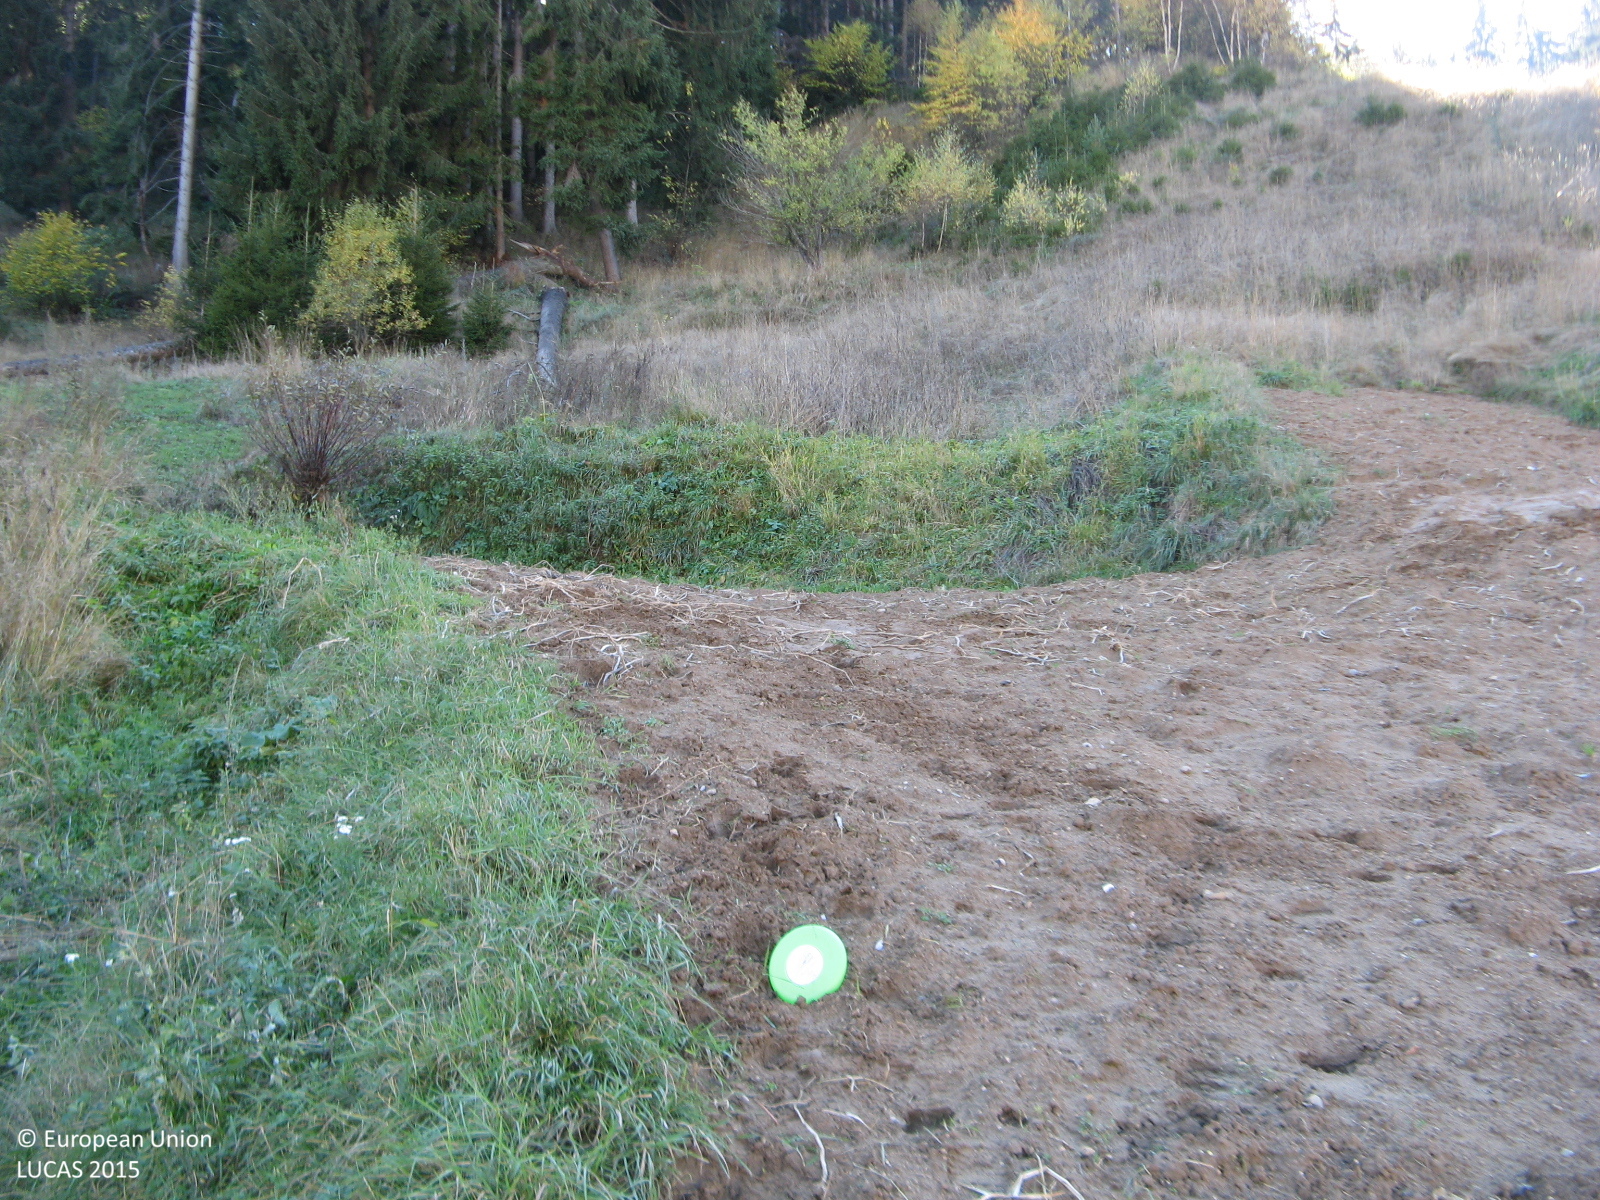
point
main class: Cropland
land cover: Potatoes
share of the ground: < 10 %
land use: Agriculture (excluding fallow land and kitchen gardens)
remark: Harvested field
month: October
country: BG
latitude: 41.7251
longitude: 24.6749
